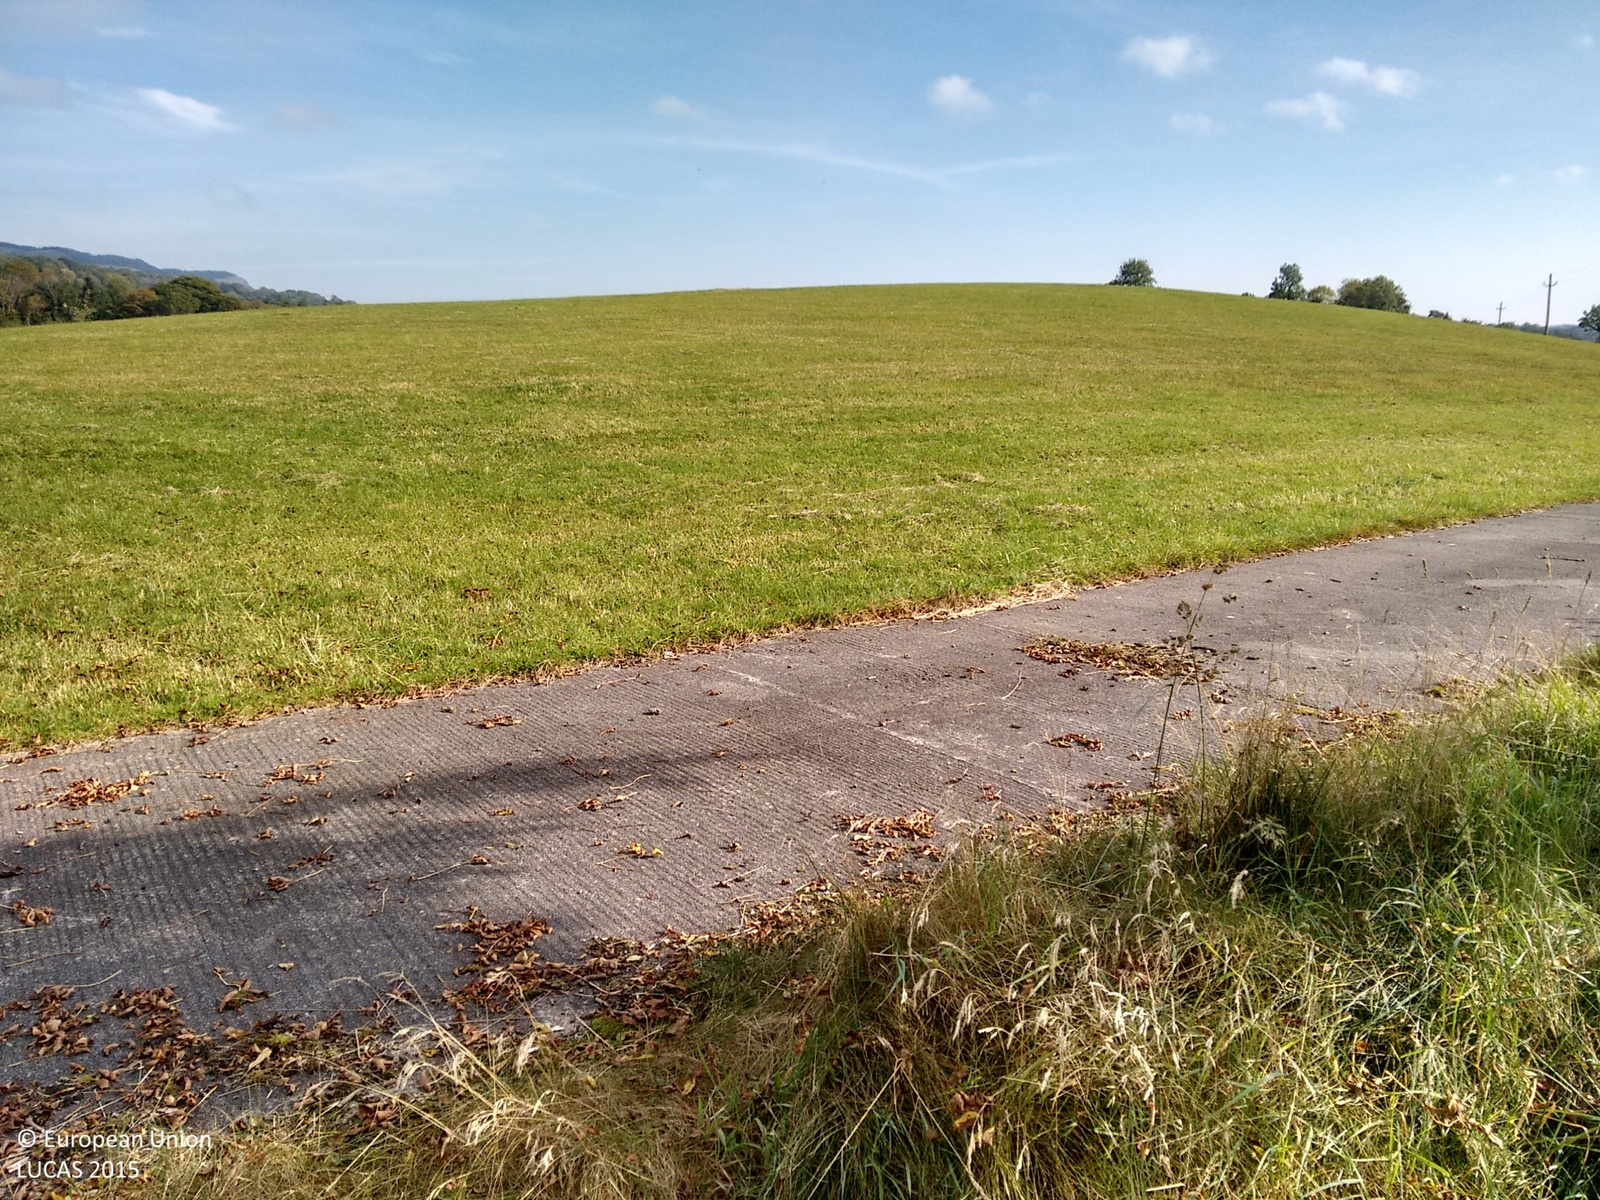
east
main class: Grassland
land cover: Grassland without tree/shrub cover
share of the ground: > 75 %
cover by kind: herbaceous plants 100 %
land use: Agriculture (excluding fallow land and kitchen gardens)
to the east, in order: Grassland without tree/shrub cover; Abandoned hedges; Grass margins; Tracks; Grassland without tree/shrub cover; Abandoned hedges; Fences; Grassland without tree/shrub cover; Shruby margins; Ditches and canals; Shruby margins; Grassland without tree/shrub cover; Fences; Grass margins; Tracks; Grassland without tree/shrub cover
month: October
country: GB
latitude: 54.2963
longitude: -7.8217
